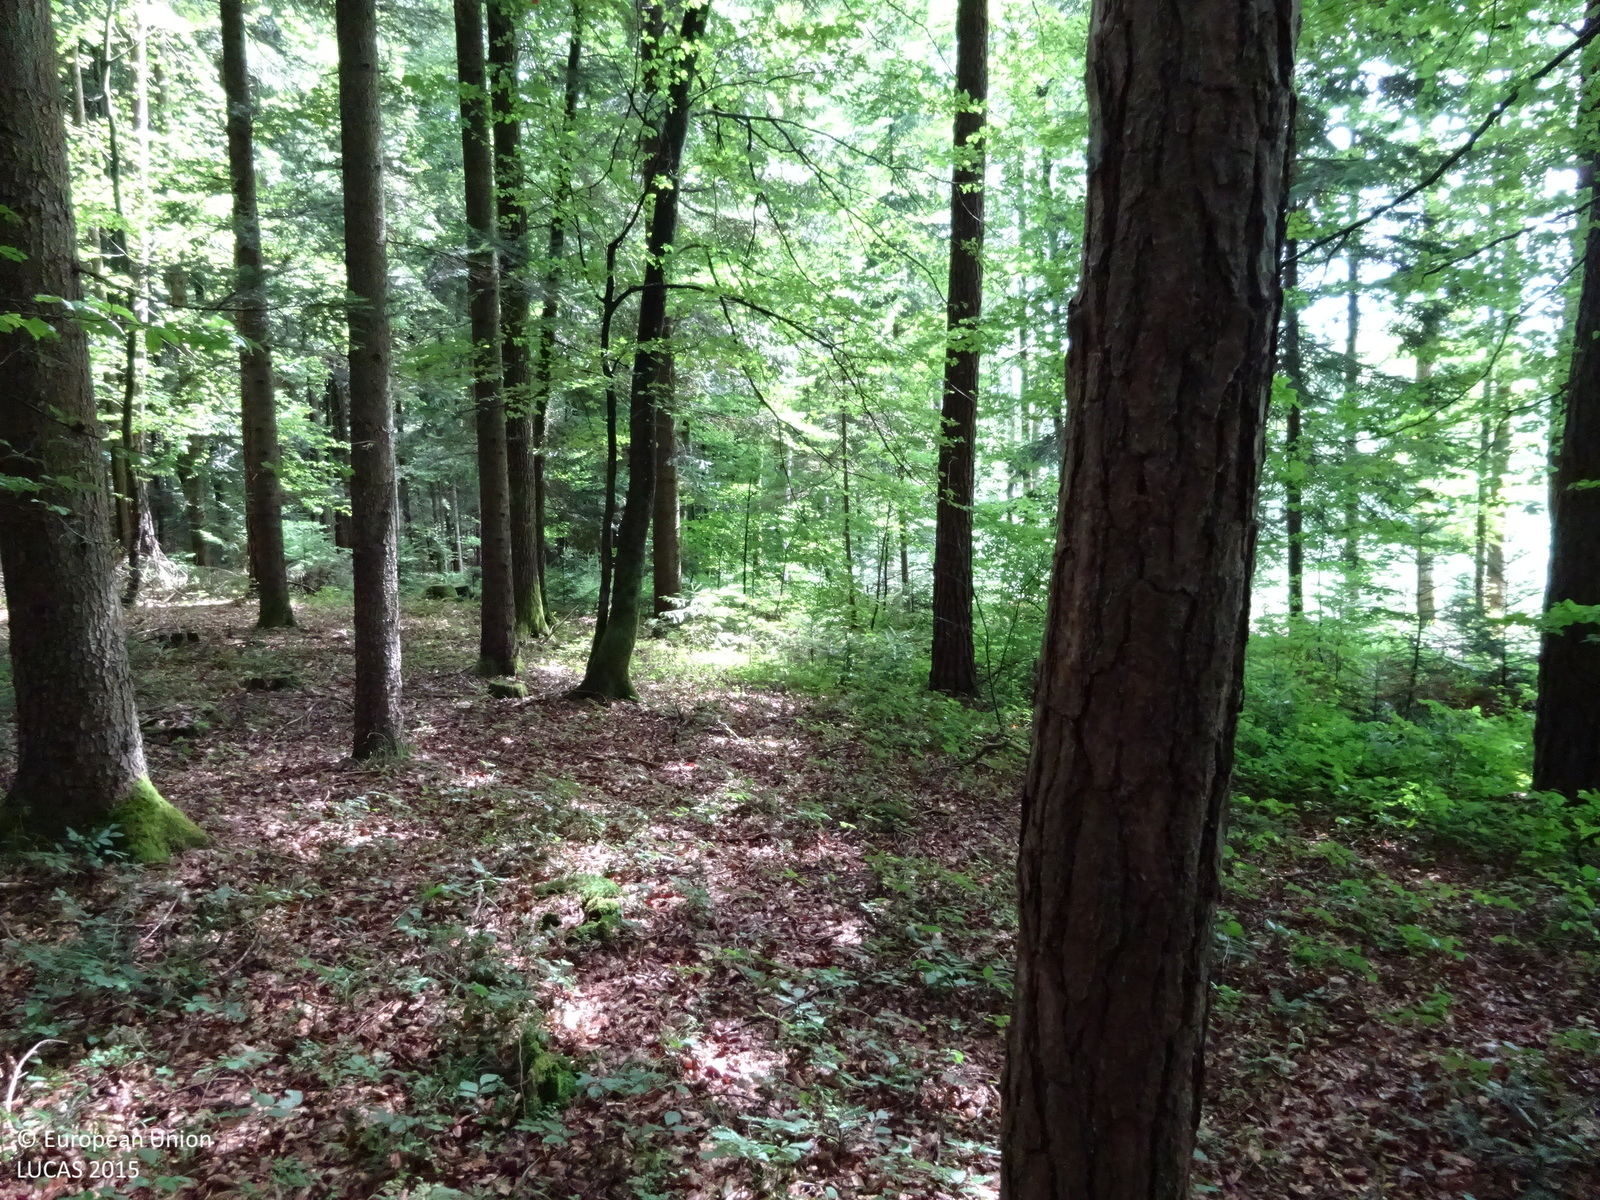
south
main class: Woodland
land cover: Pine dominated mixed woodland
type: mountainous beech forest
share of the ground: > 75 %
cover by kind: broadleaved forest trees 65 %, coniferous forest trees 25 %, herbaceous plants 10 %
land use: Forestry
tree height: > 5 m
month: July
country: AT
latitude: 46.8509
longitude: 15.3106
